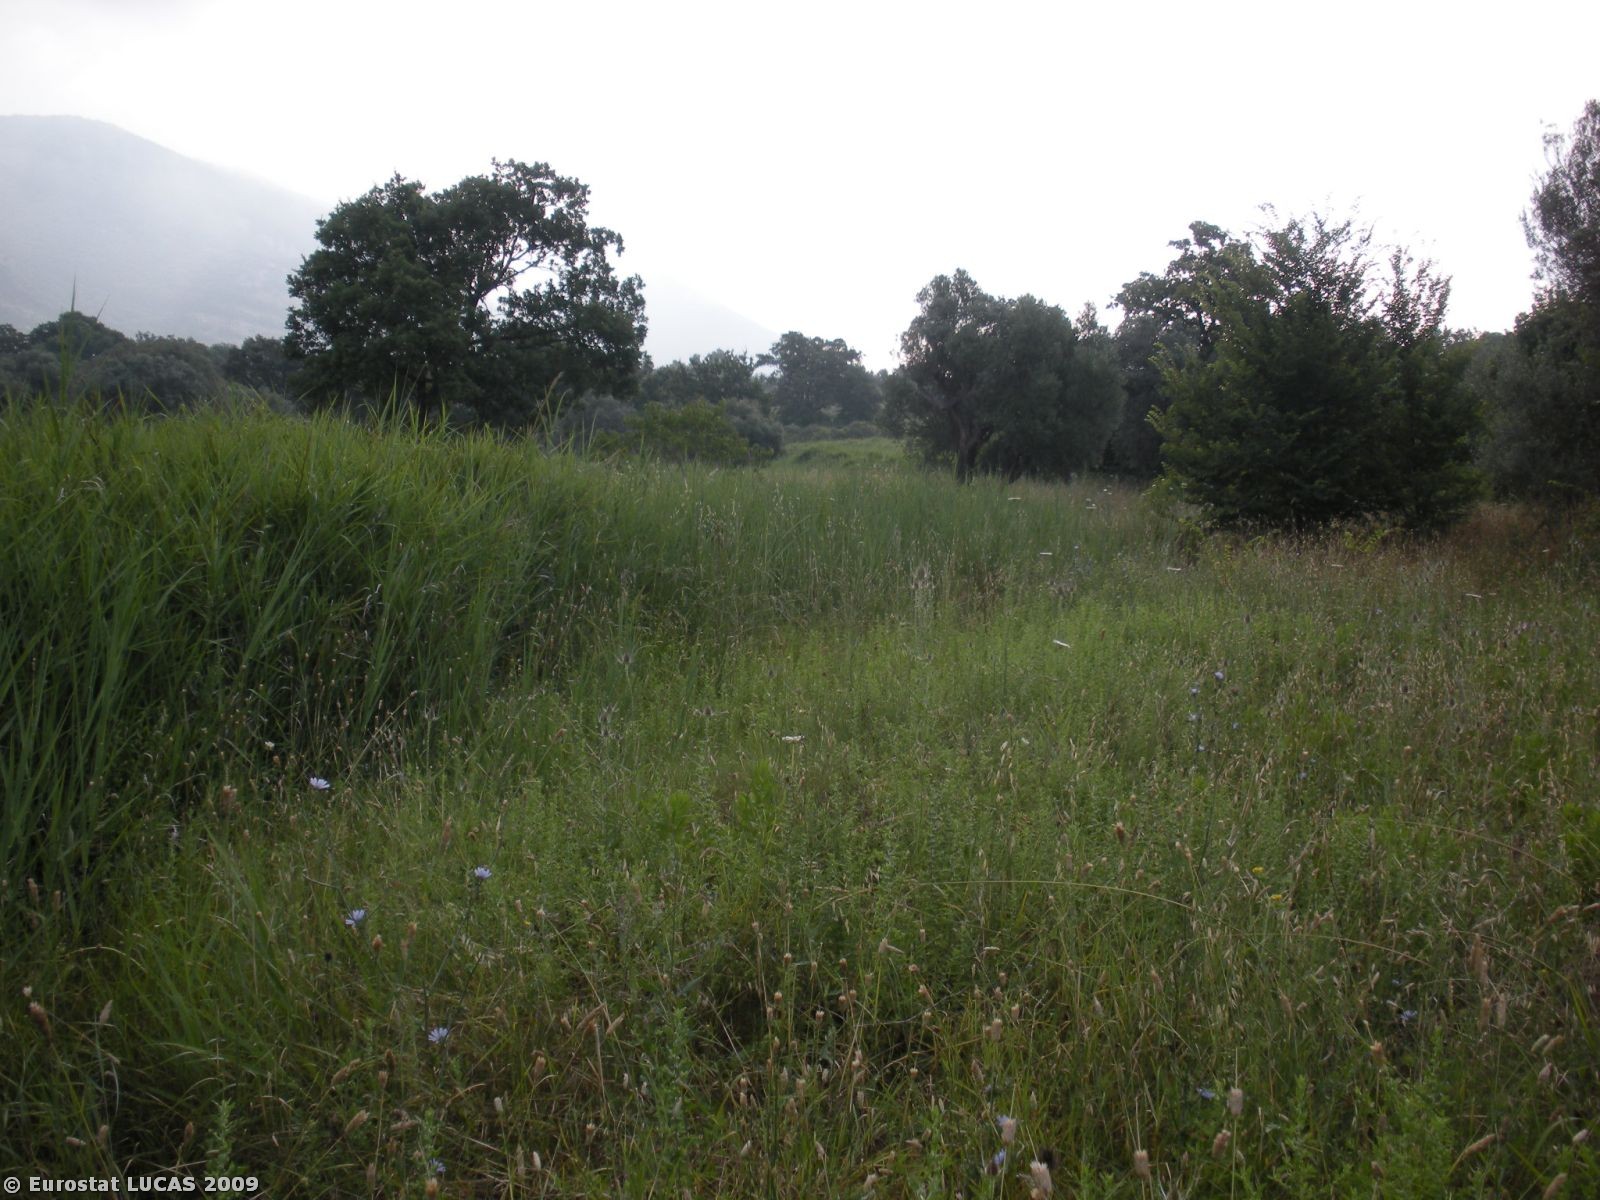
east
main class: Grassland
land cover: Grassland with sparse tree/shrub cover
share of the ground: > 75 %
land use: Fallow land
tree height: < 5 m
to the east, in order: Grassland with sparse tree/shrub cover; Olive groves; Grassland with sparse tree/shrub cover; Shrubland without tree cover; Olive groves; Grassland with sparse tree/shrub cover; Shrubland without tree cover; Olive groves; Grassland with sparse tree/shrub cover
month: July
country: IT
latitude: 40.4269
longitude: 15.0584
